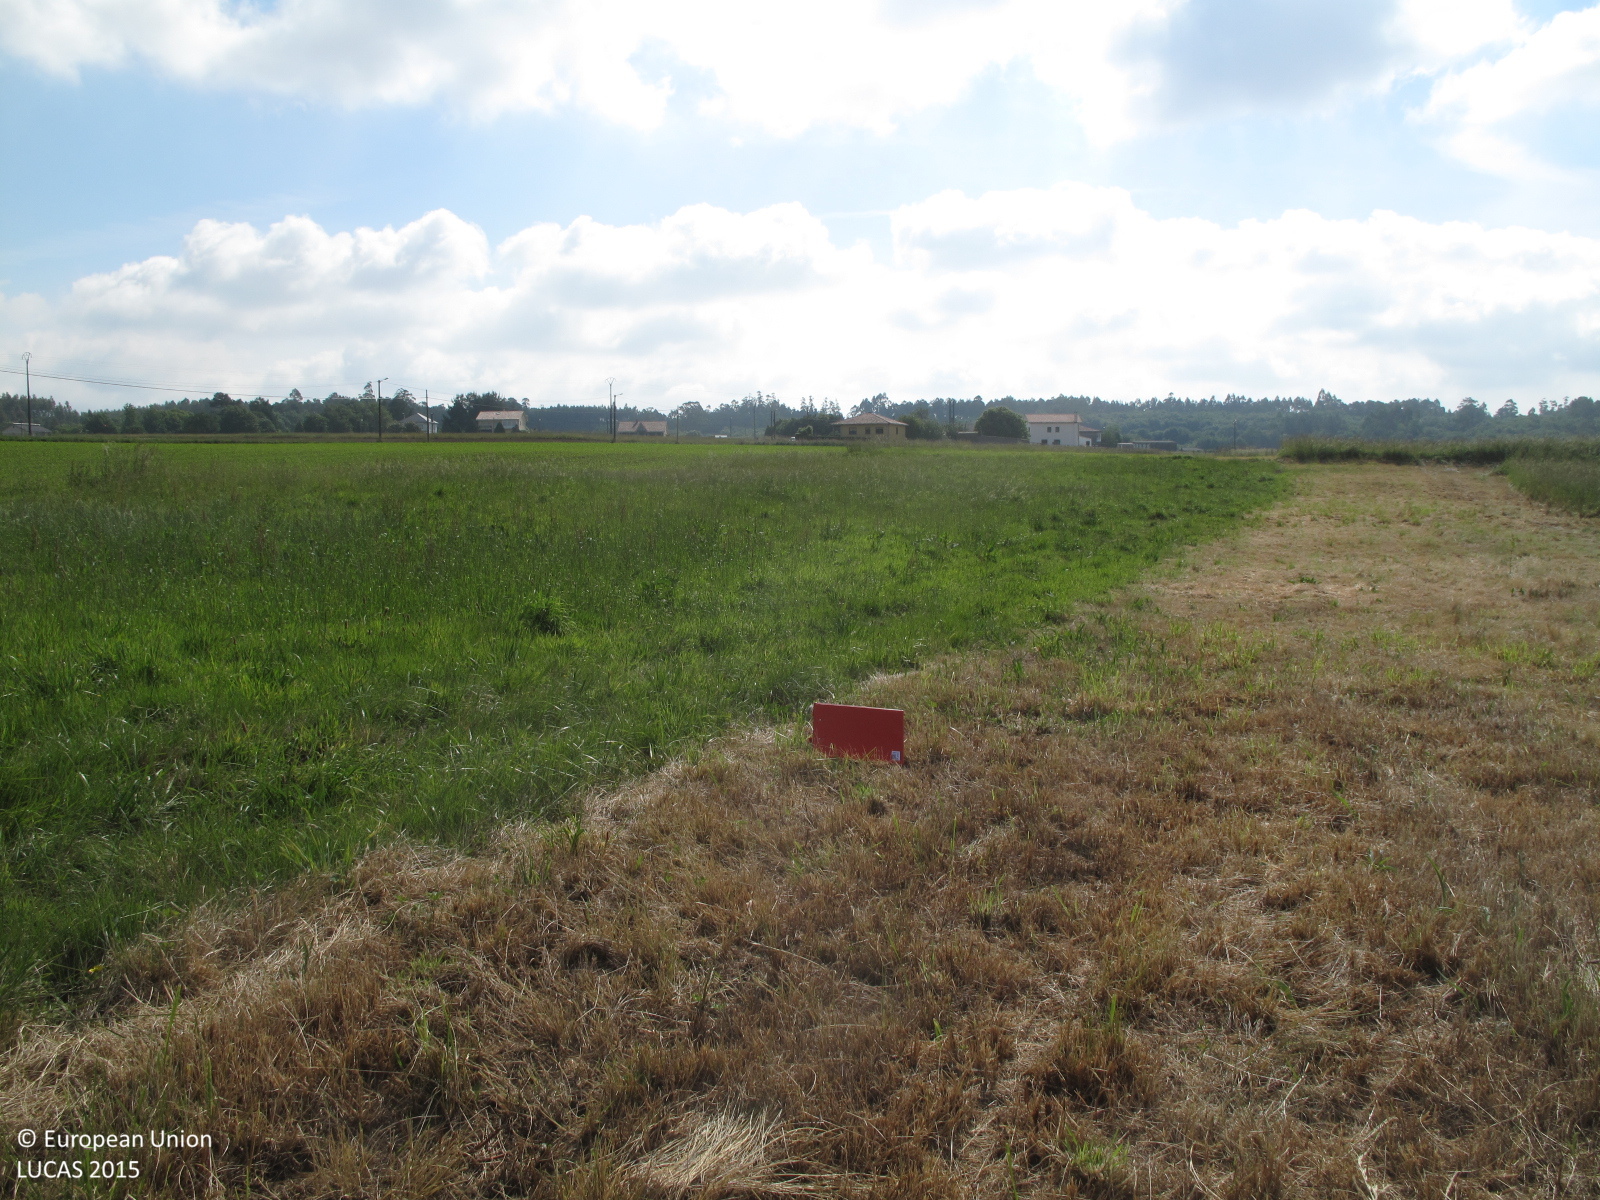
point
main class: Grassland
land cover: Grassland without tree/shrub cover
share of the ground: > 75 %
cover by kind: herbaceous plants 100 %
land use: Agriculture (excluding fallow land and kitchen gardens)
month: June
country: ES
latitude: 42.9374
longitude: -8.4472
